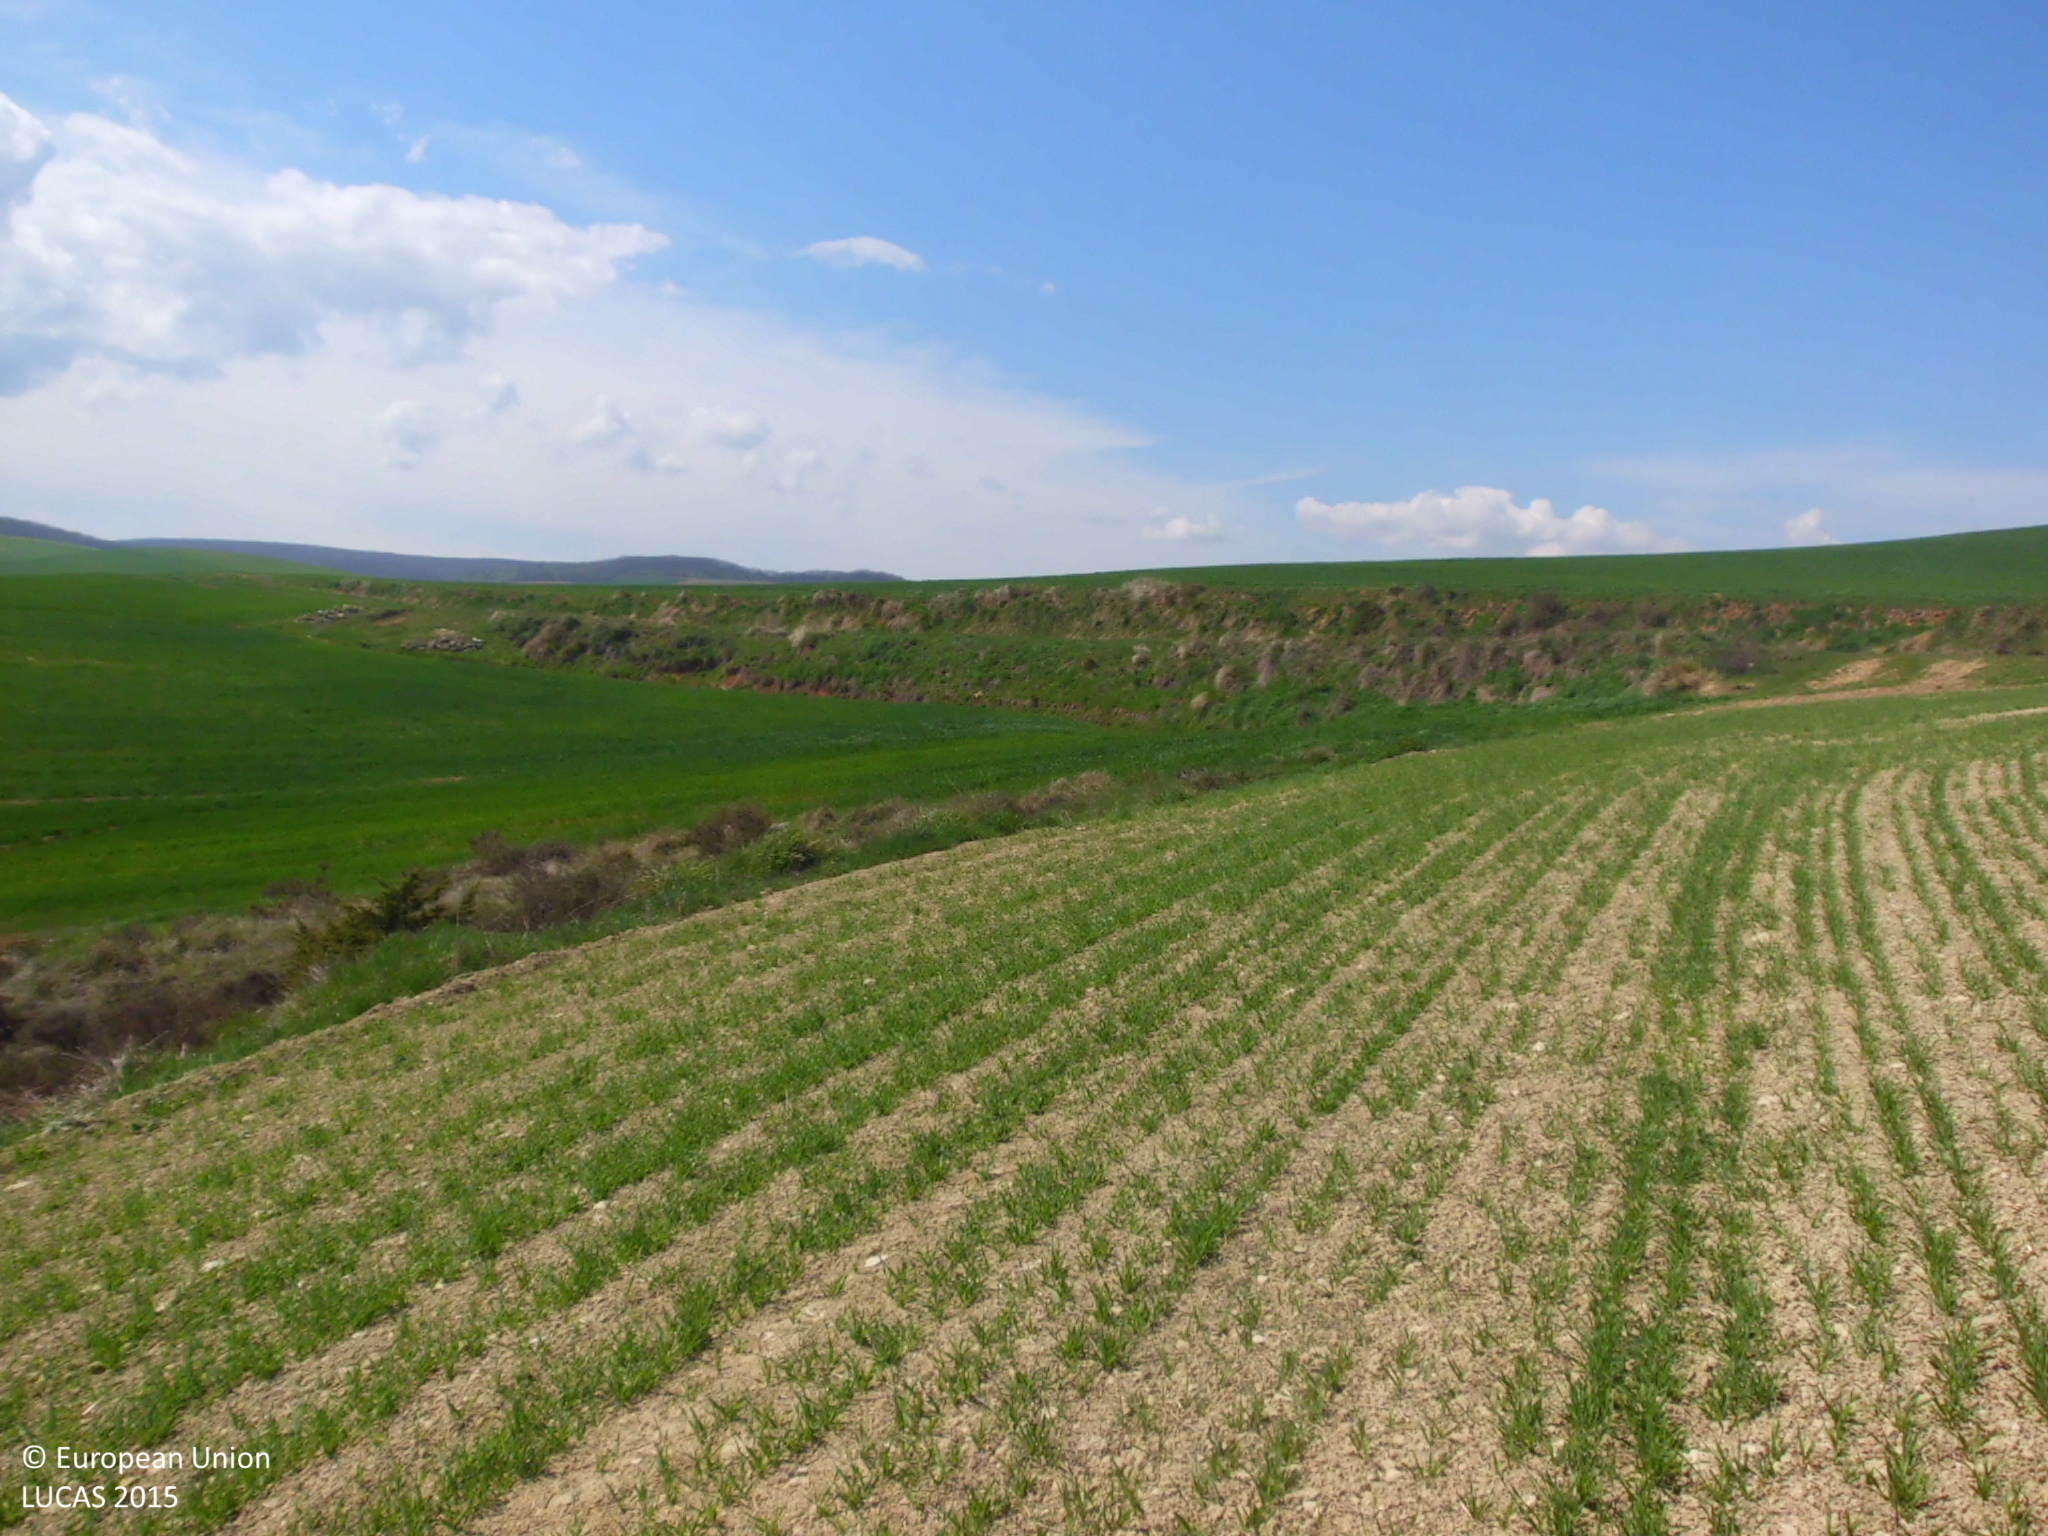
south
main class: Cropland
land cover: Barley
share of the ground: 10 - 25 %
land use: Agriculture (excluding fallow land and kitchen gardens)
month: April
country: ES
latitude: 42.4220
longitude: -3.3644
